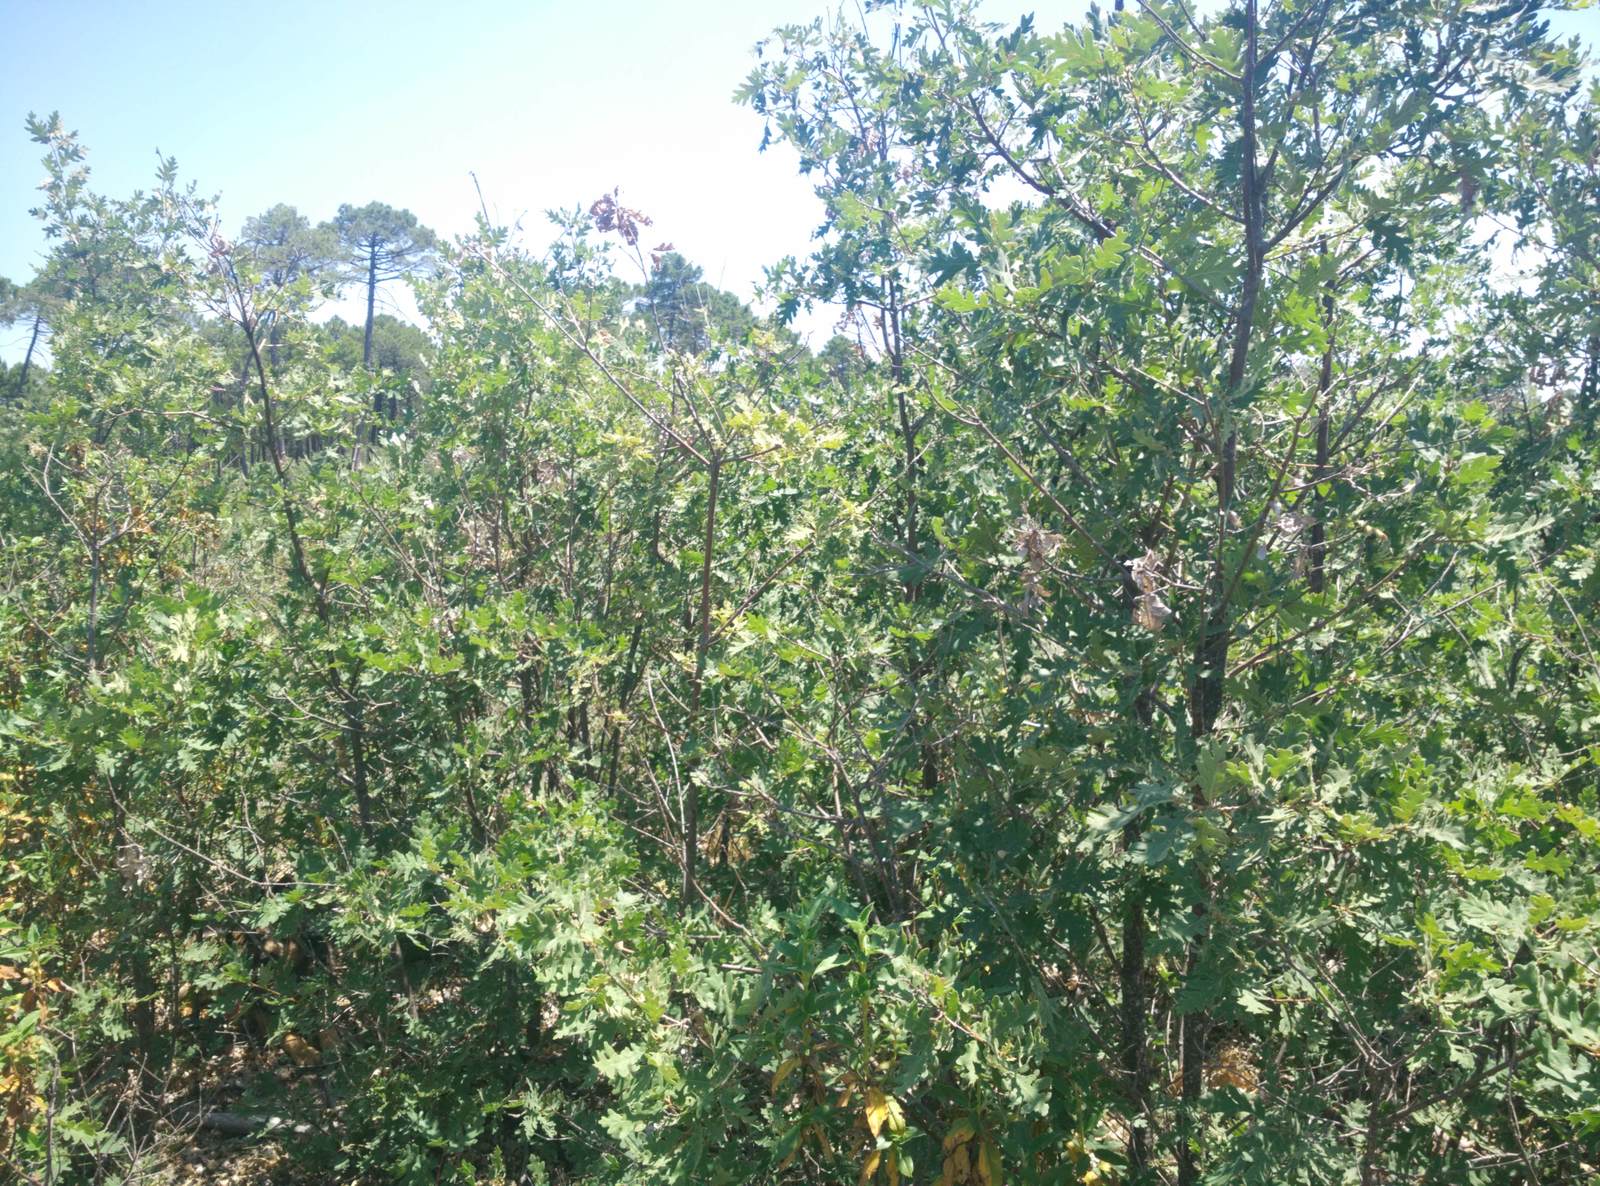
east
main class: Shrubland
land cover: Shrubland without tree cover
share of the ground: > 75 %
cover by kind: shrubs 80 %, unconsolidated bare surface 15 %, herbaceous plants 5 %
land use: Semi-natural and natural areas not in use
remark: Burnt area
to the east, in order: Shrubland without tree cover; Pine dominated coniferous woodland; Tracks; Pine dominated coniferous woodland
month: July
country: ES
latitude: 40.9011
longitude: -2.1214
